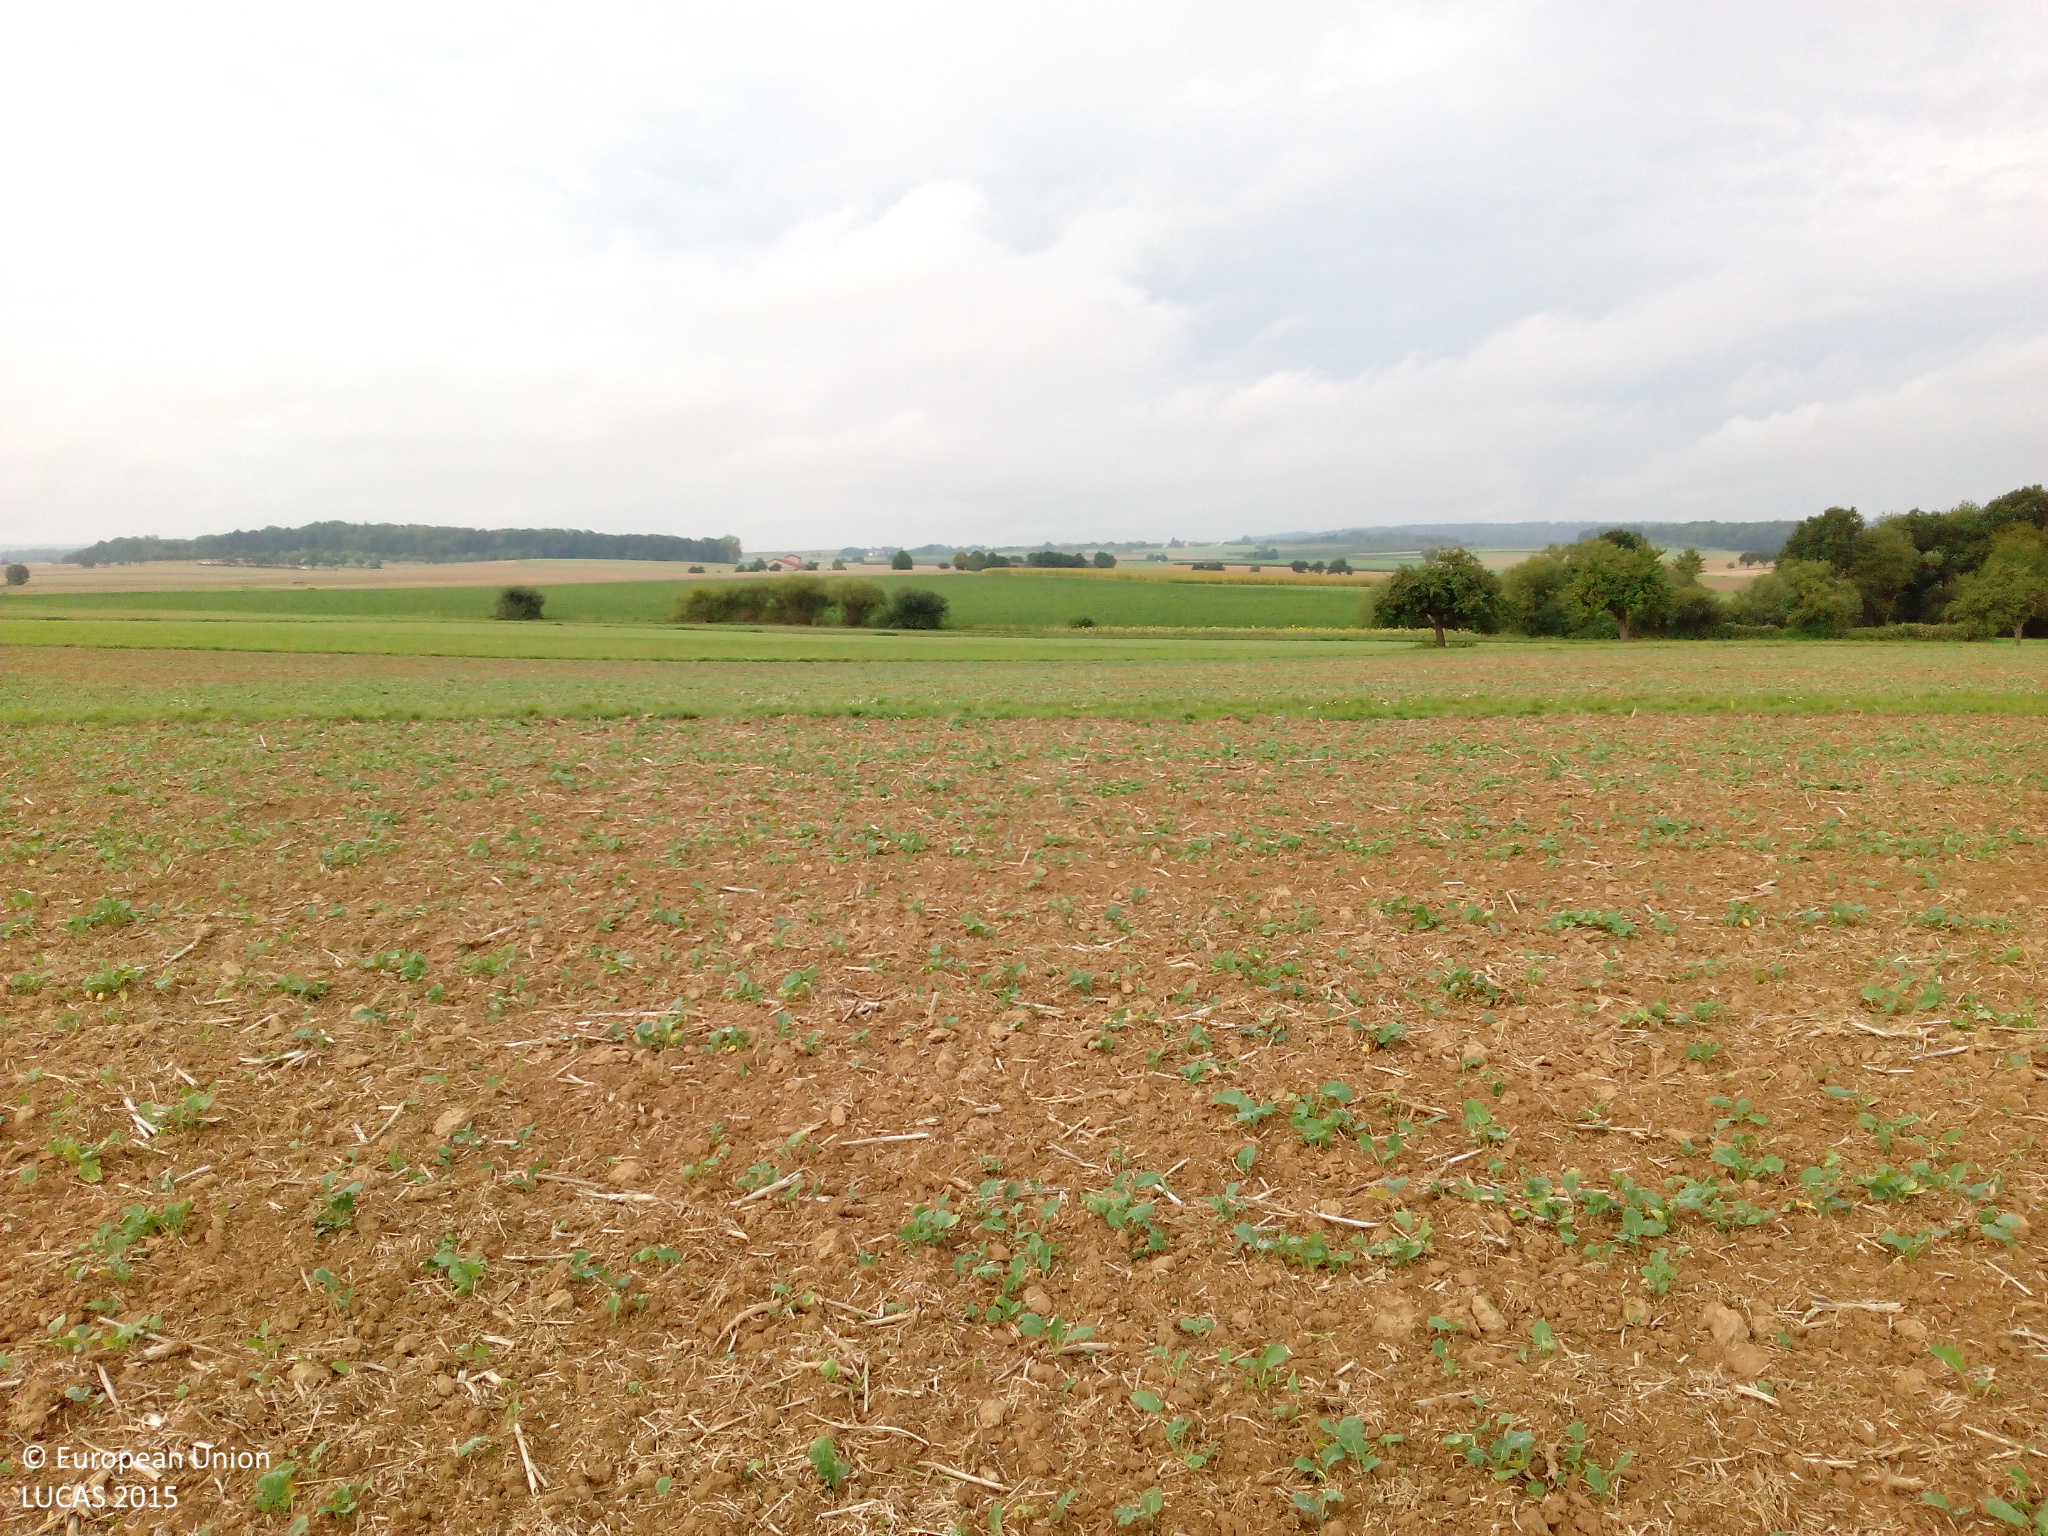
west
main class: Cropland
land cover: Rape and turnip rape
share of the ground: < 10 %
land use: Agriculture (excluding fallow land and kitchen gardens)
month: September
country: DE
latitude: 49.7151
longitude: 9.4038
